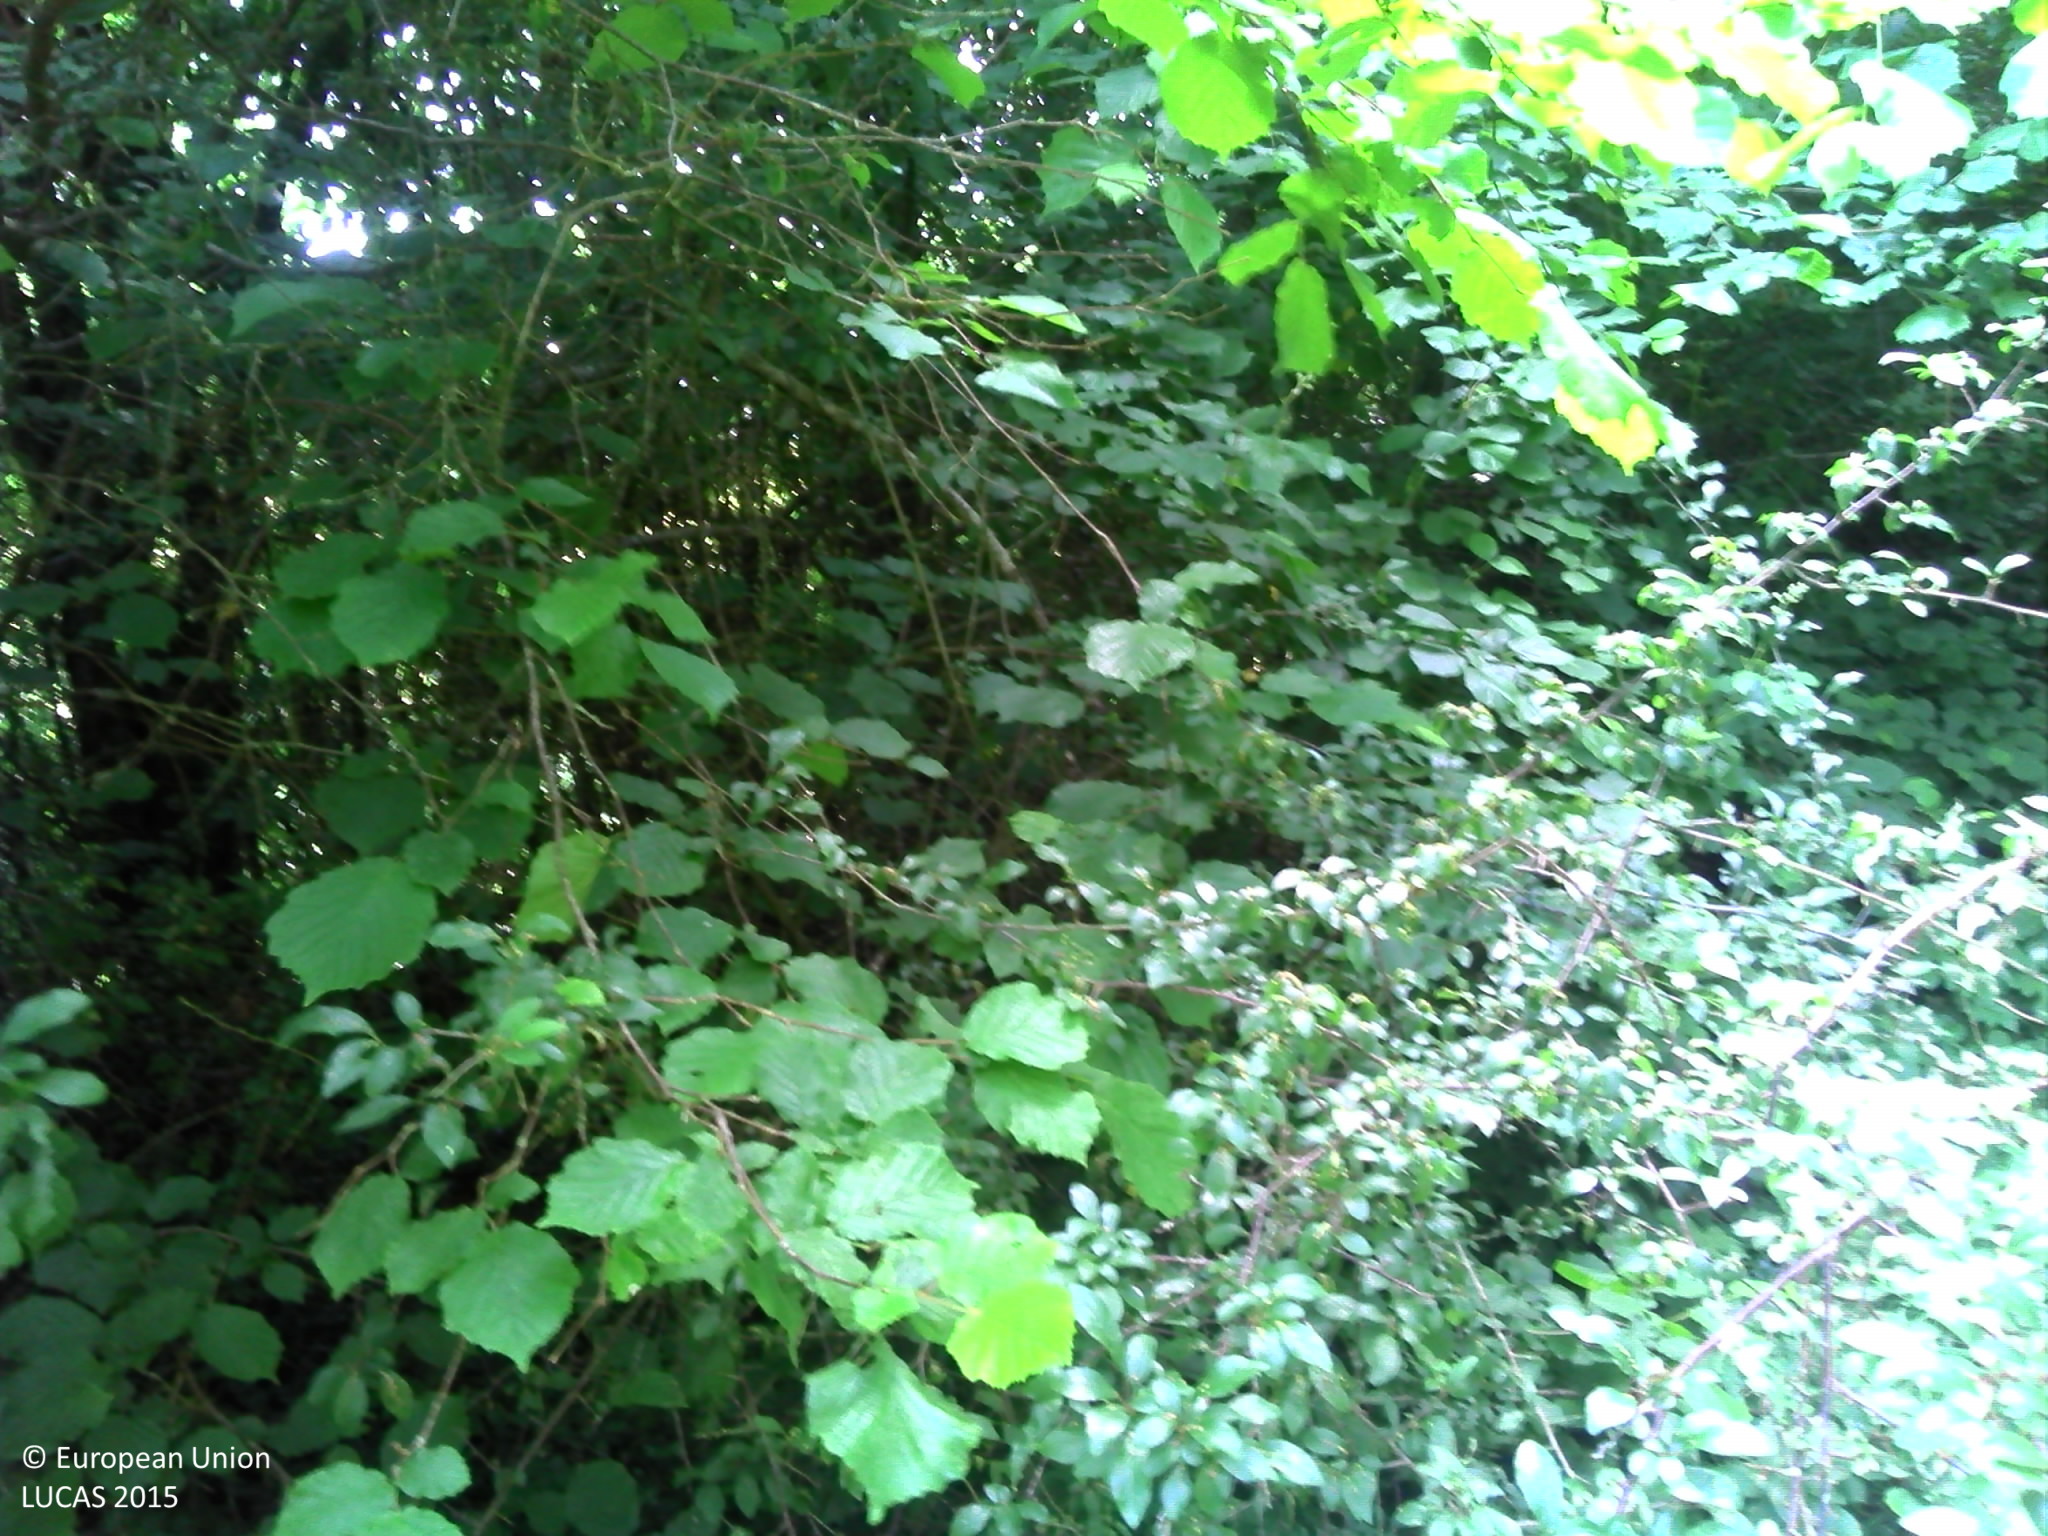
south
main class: Woodland
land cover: Broadleaved woodland
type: mesophytic deciduous forest
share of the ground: > 75 %
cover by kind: broadleaved forest trees 95 %, lichens and mosses 5 %
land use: Forestry
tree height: > 5 m
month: June
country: FR
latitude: 48.5938
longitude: 0.1141
